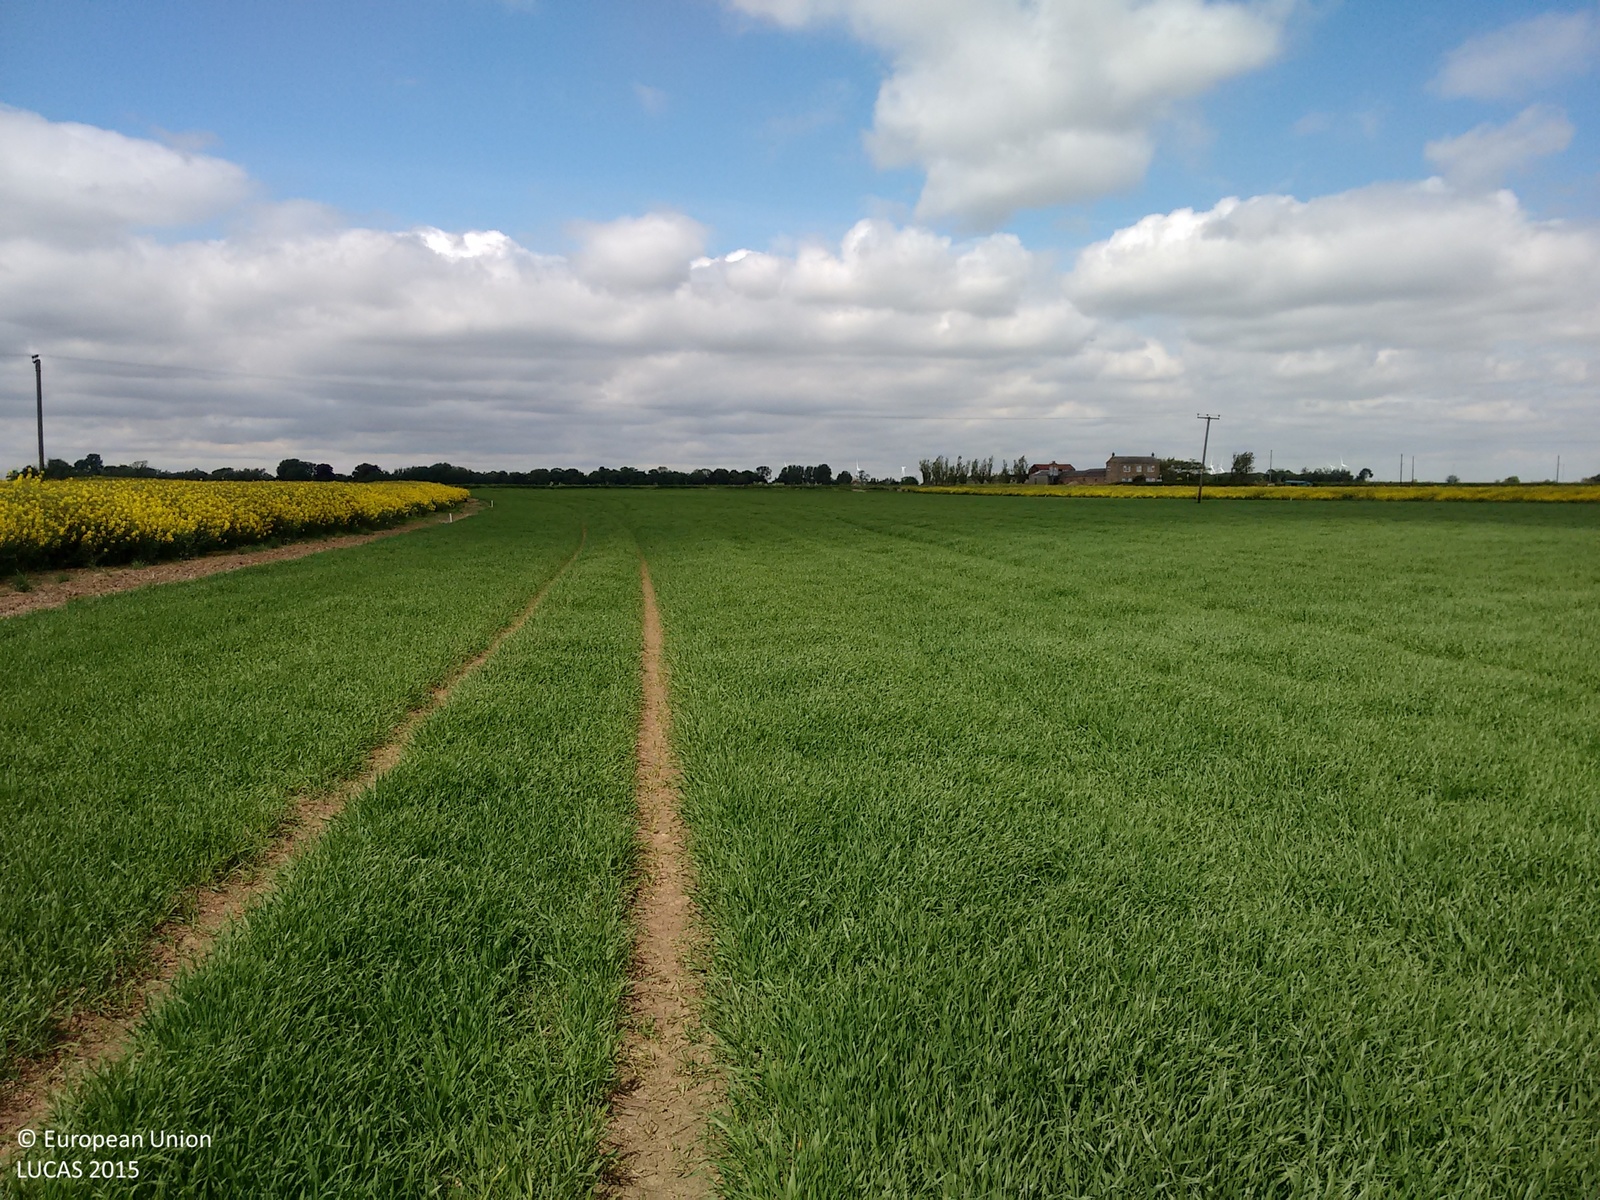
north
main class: Cropland
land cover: Barley
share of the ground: > 75 %
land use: Agriculture (excluding fallow land and kitchen gardens)
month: May
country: GB
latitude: 53.6968
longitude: -0.8093
